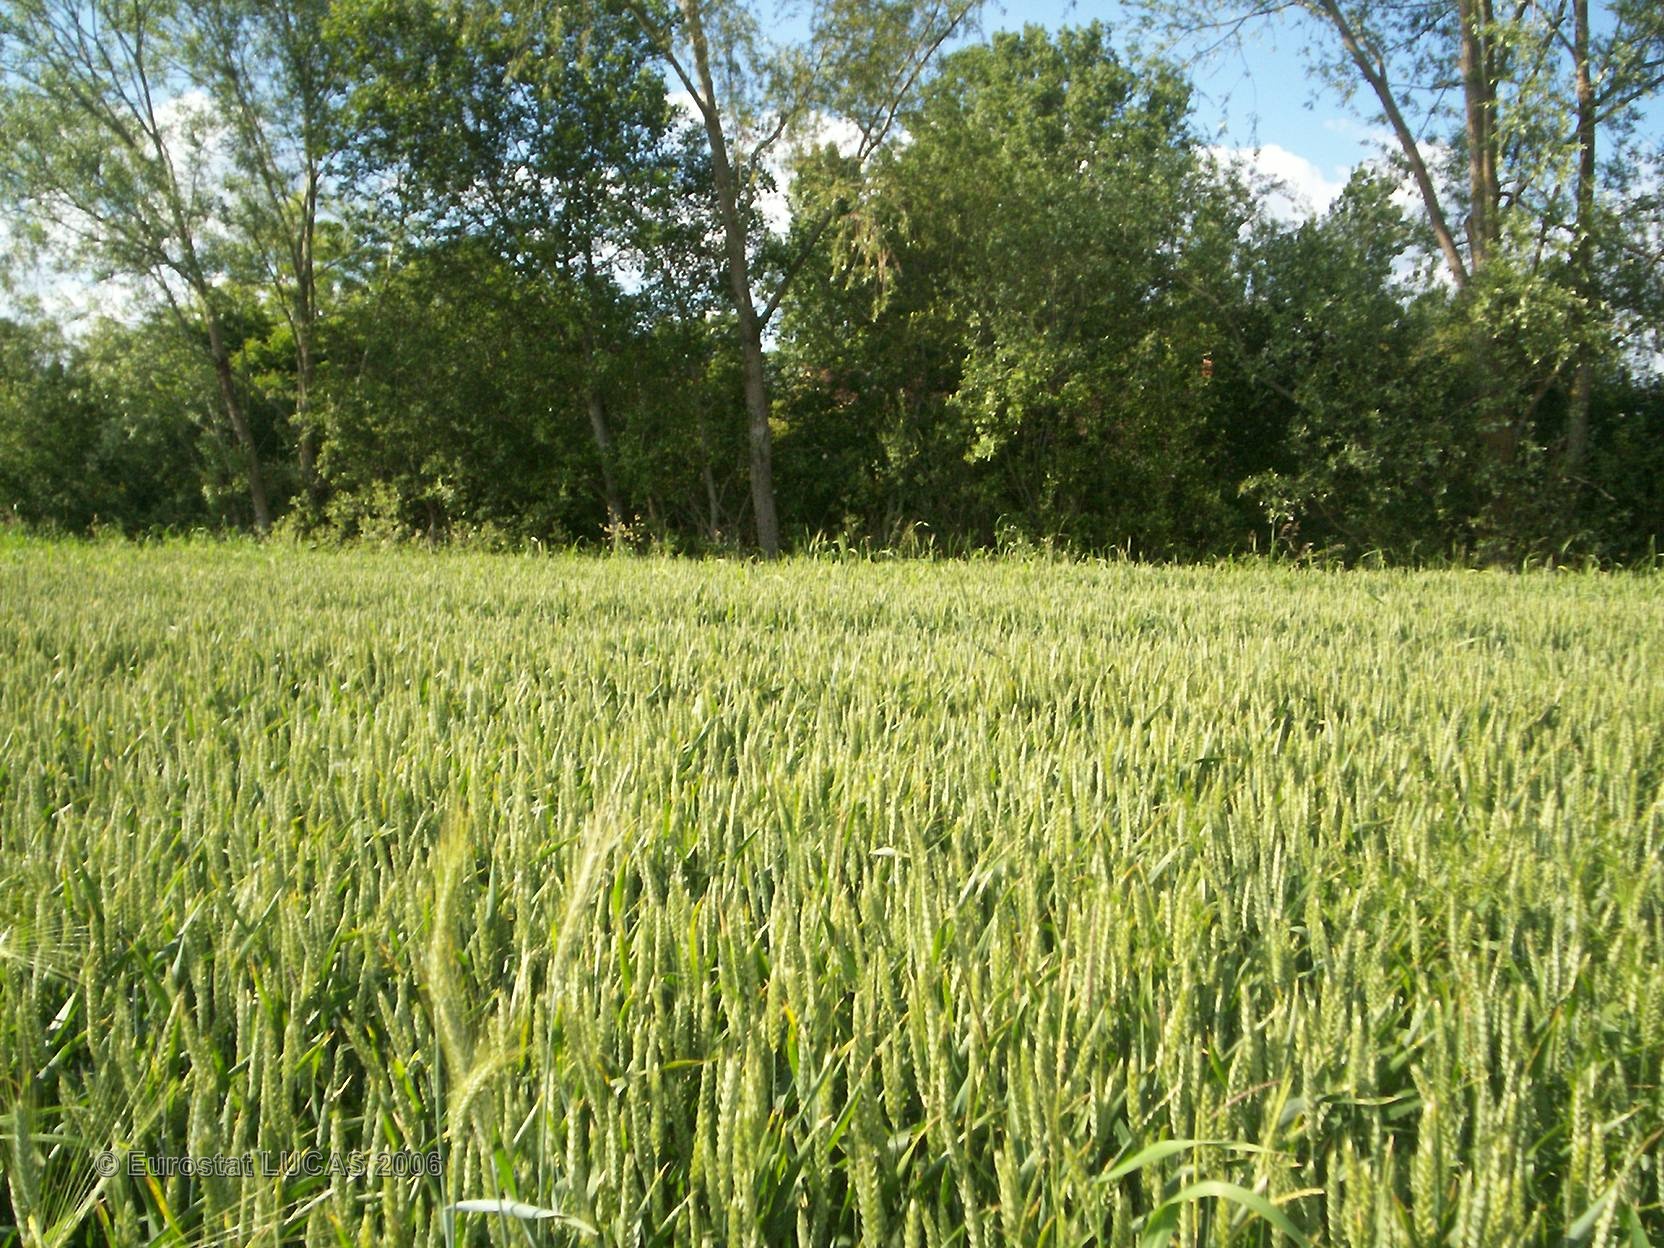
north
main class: Cropland
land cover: Common wheat
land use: Agriculture (excluding fallow land and kitchen gardens)
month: June
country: FR
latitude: 46.2196
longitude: 3.1146
